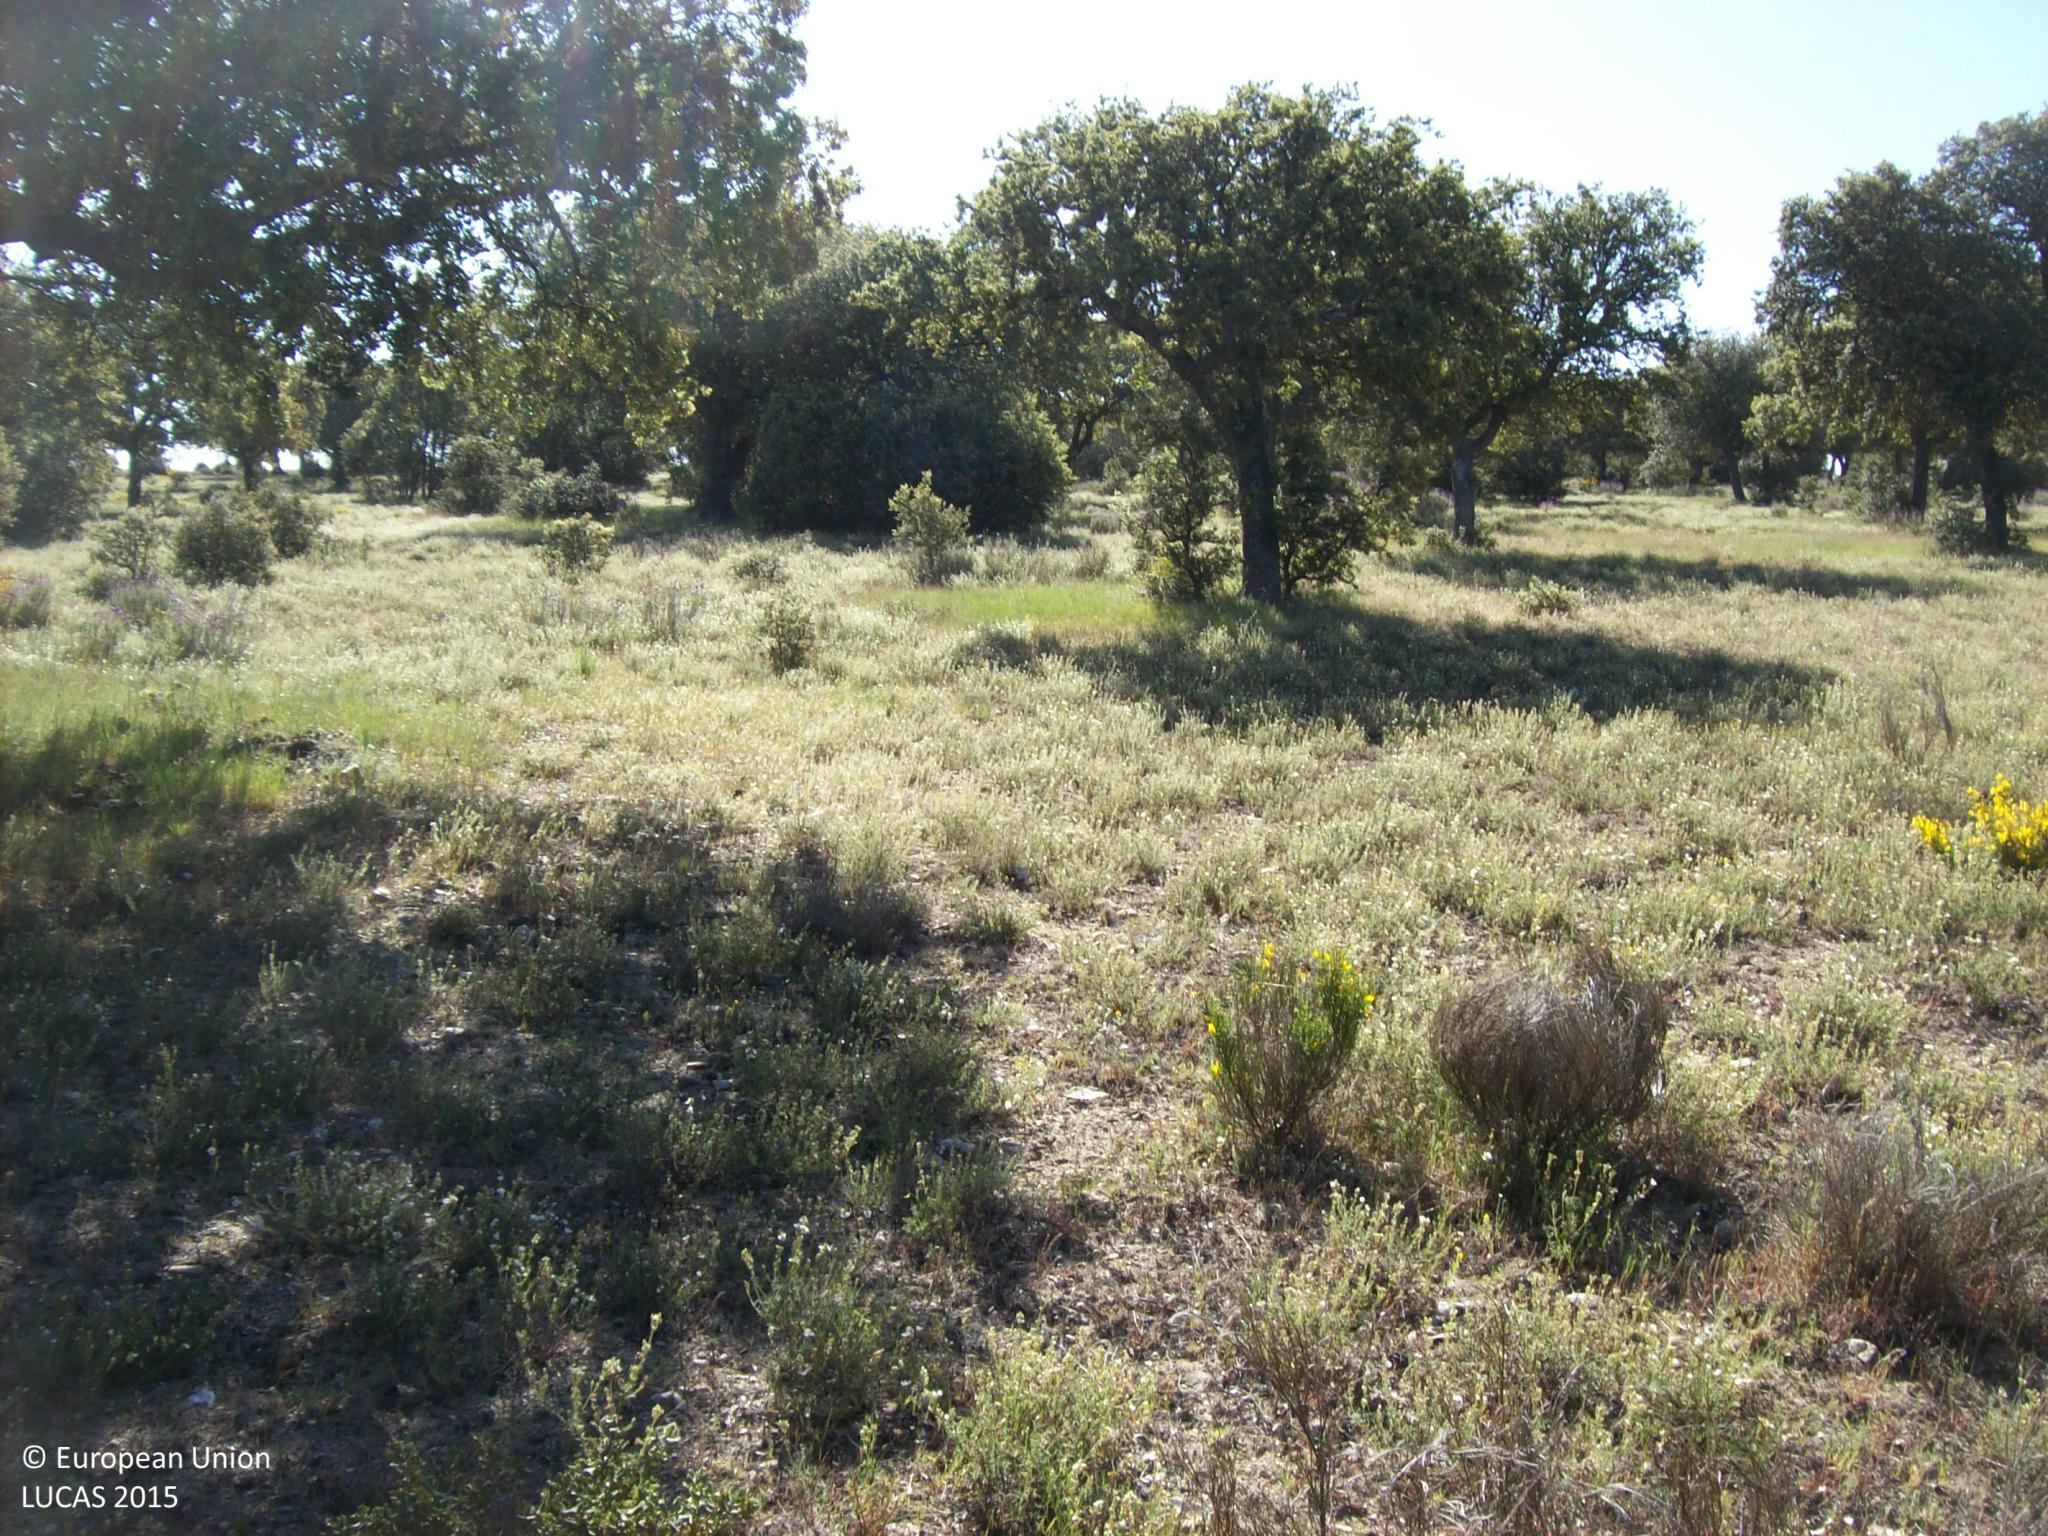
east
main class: Woodland
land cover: Broadleaved woodland
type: broadleaved evergreen forest
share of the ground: 25 - 50 %
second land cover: Grassland without tree/shrub cover
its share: 50 - 75 %
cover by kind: herbaceous plants 65 %, broadleaved forest trees 30 %, shrubs 5 %
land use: Forestry
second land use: Agriculture (excluding fallow land and kitchen gardens)
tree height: > 5 m
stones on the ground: 10 - 25 %
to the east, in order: Broadleaved woodland; Grassland without tree/shrub cover; Shrubland with sparse tree cover; Tracks; Common wheat
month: May
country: ES
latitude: 40.5682
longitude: -4.9291
